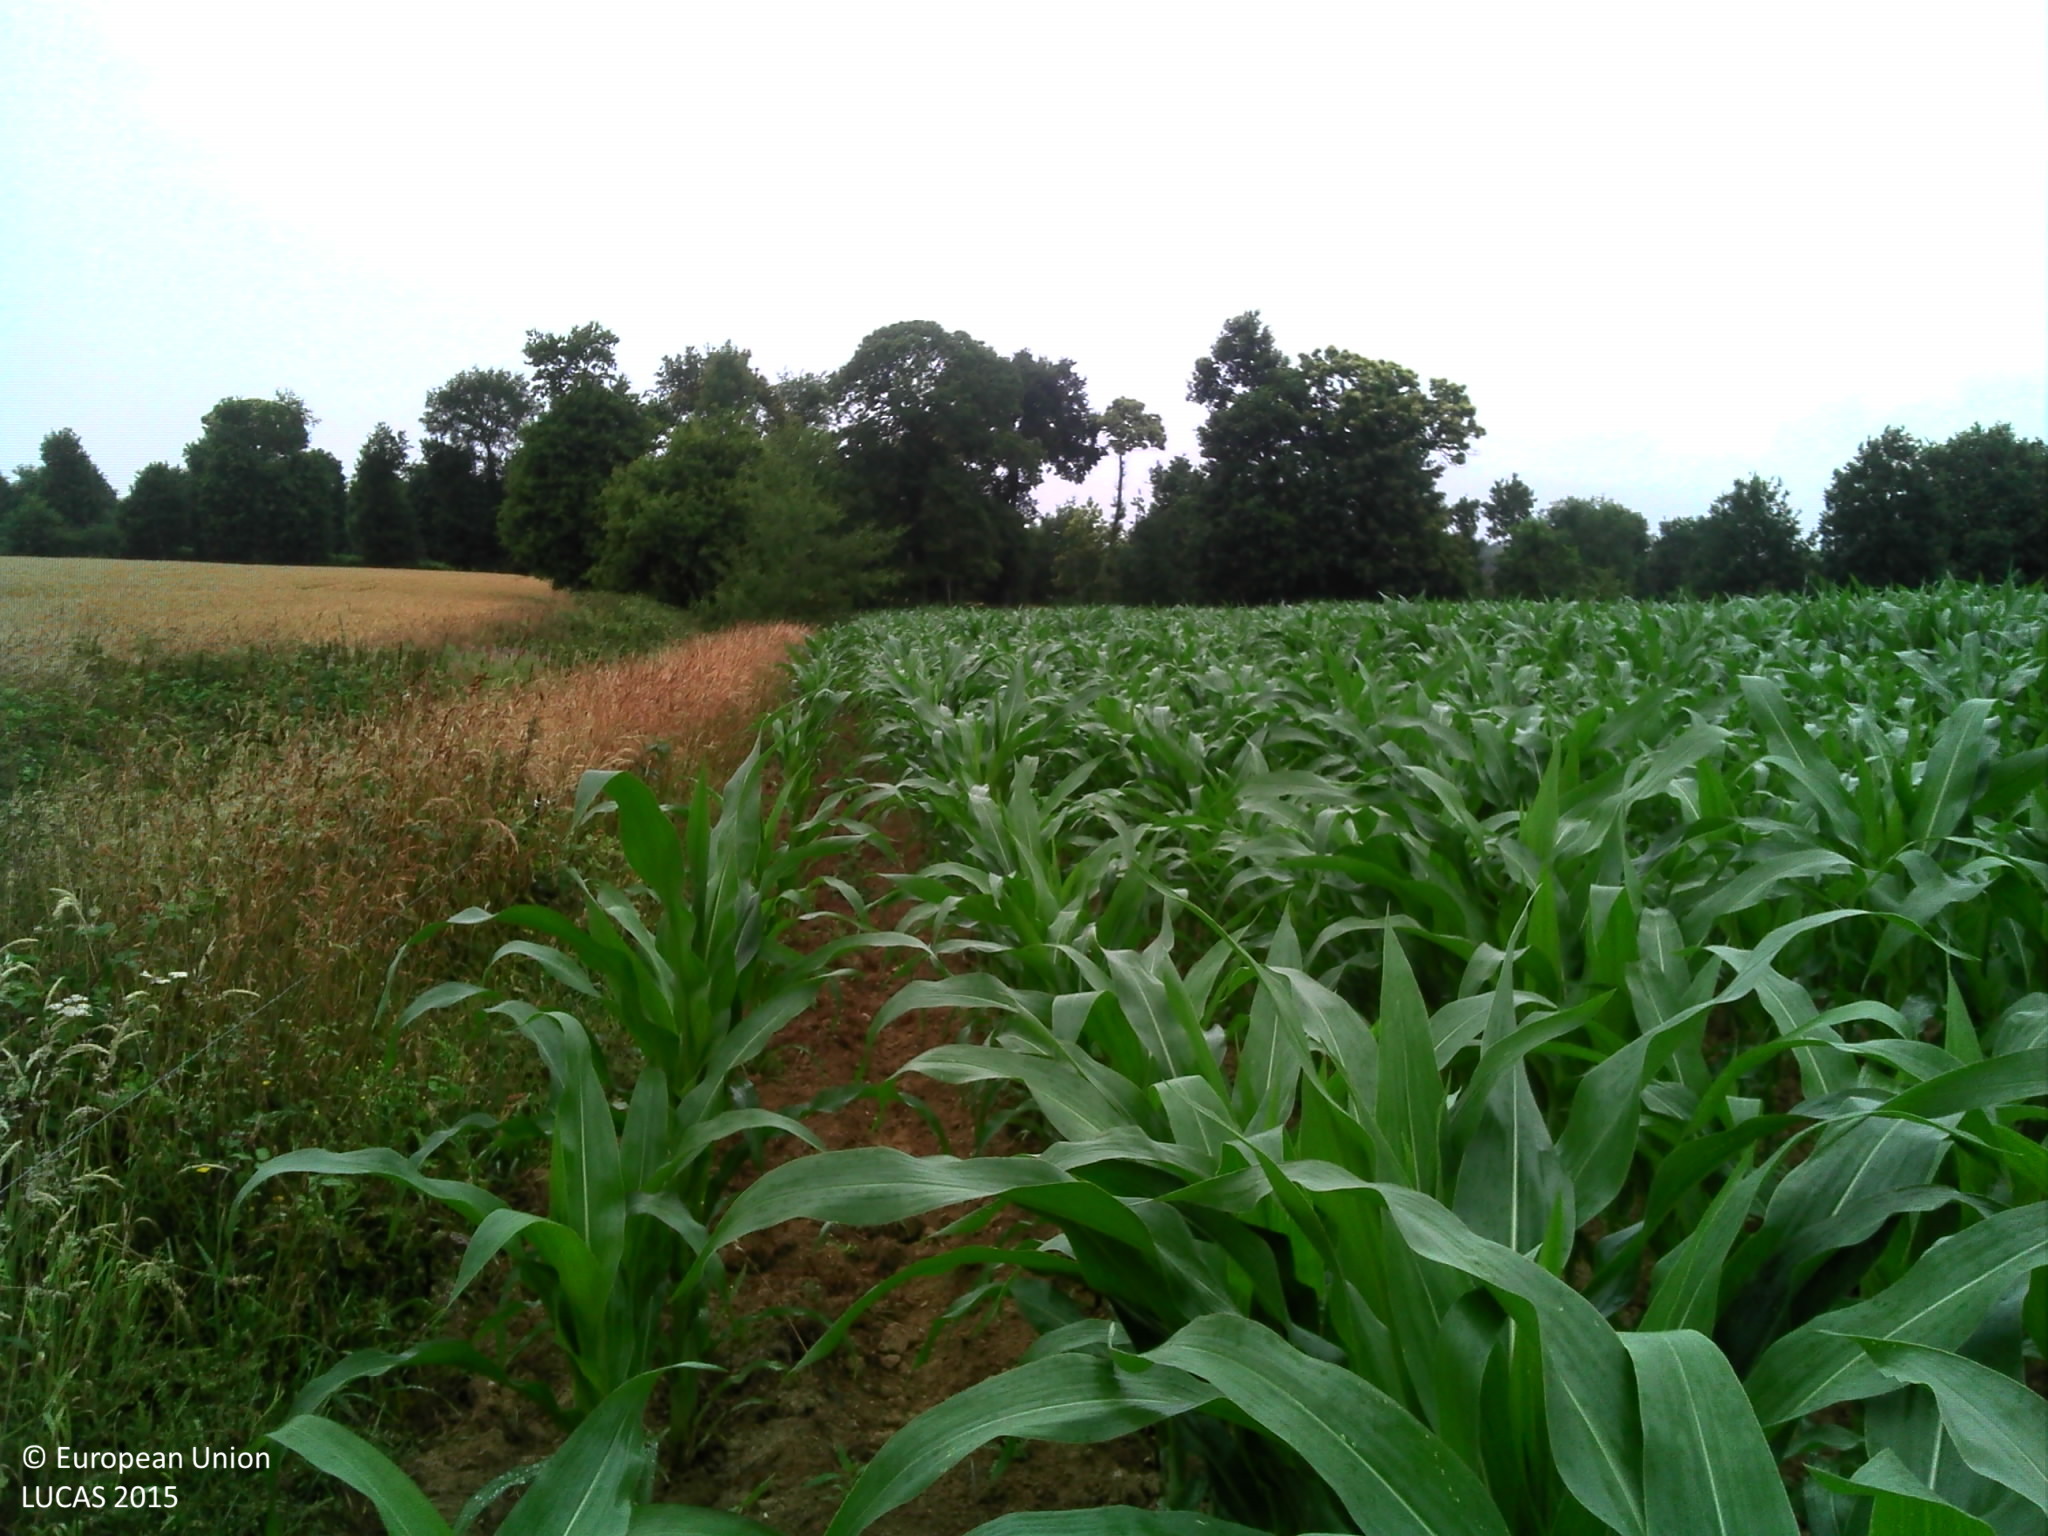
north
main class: Cropland
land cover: Maize
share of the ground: > 75 %
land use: Agriculture (excluding fallow land and kitchen gardens)
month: July
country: FR
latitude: 48.2388
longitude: -1.9962
